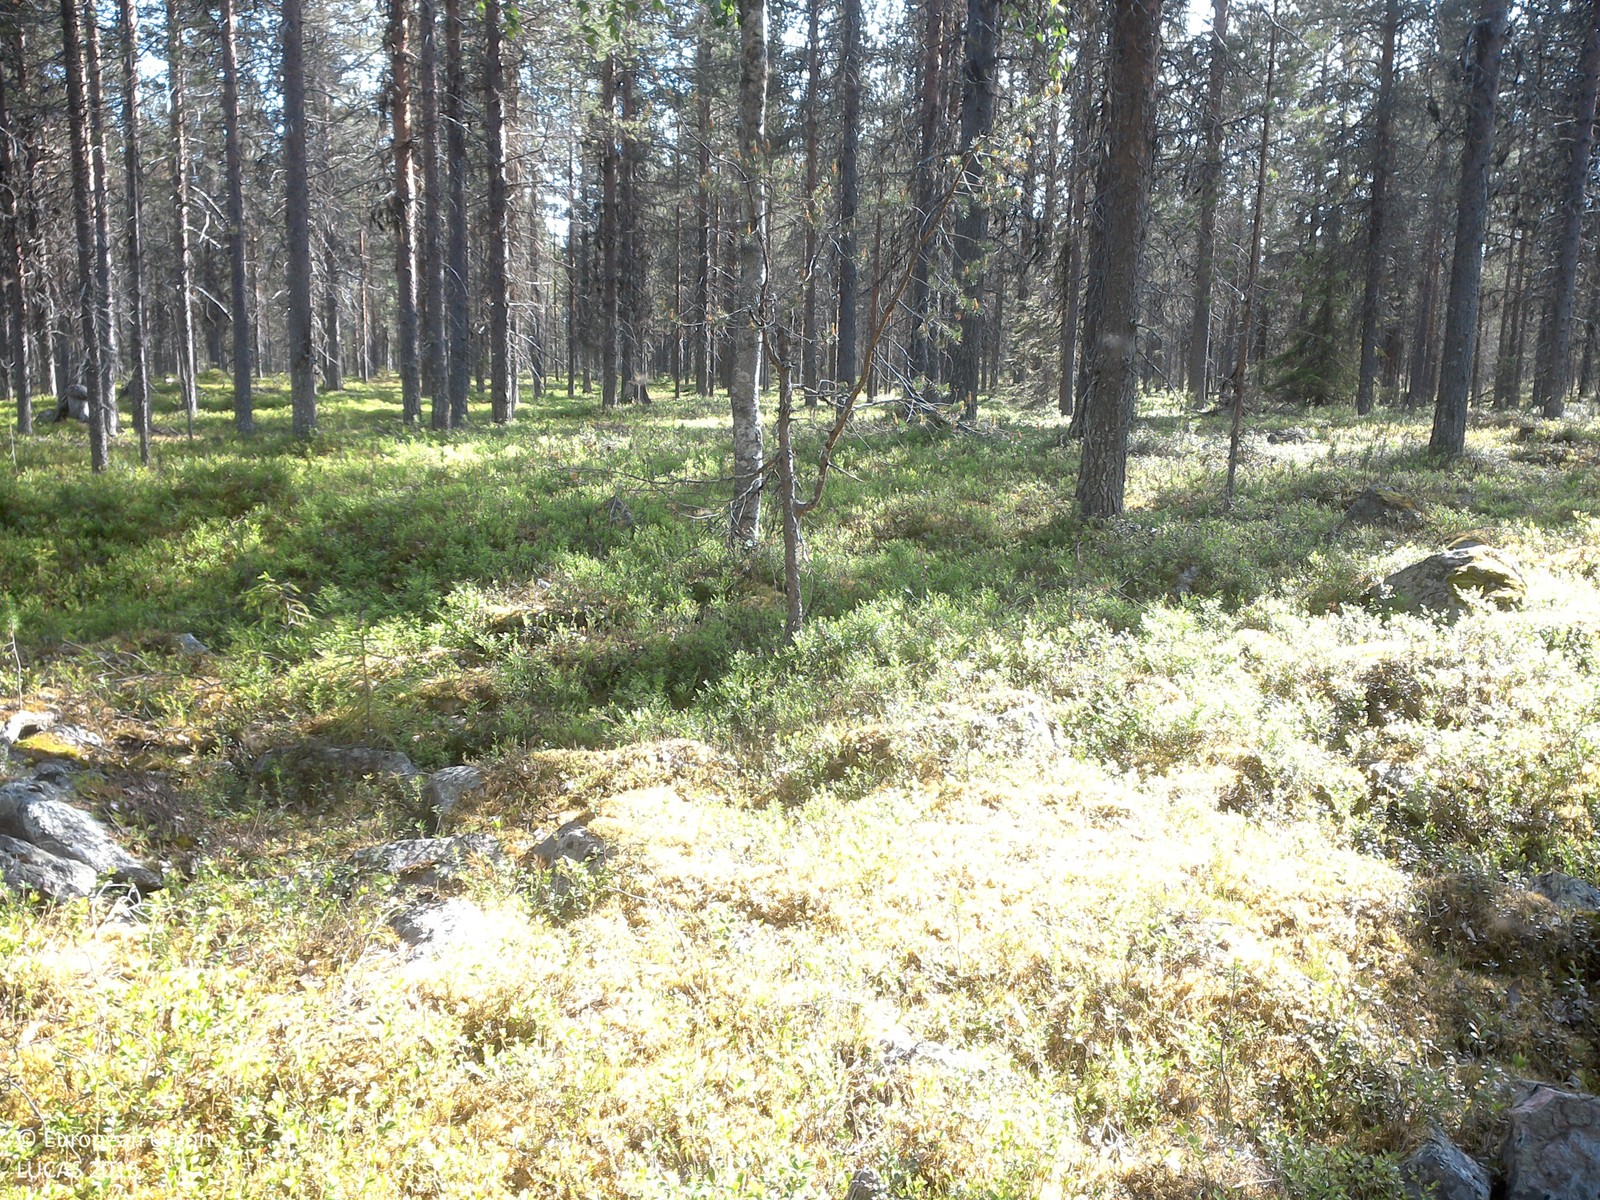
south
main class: Woodland
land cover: Pine dominated coniferous woodland
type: boreal forest
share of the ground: 25 - 50 %
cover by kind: shrubs 60 %, coniferous forest trees 25 %, lichens and mosses 10 %, broadleaved forest trees 5 %
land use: Forestry
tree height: > 5 m
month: July
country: SE
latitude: 67.5483
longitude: 23.3647
